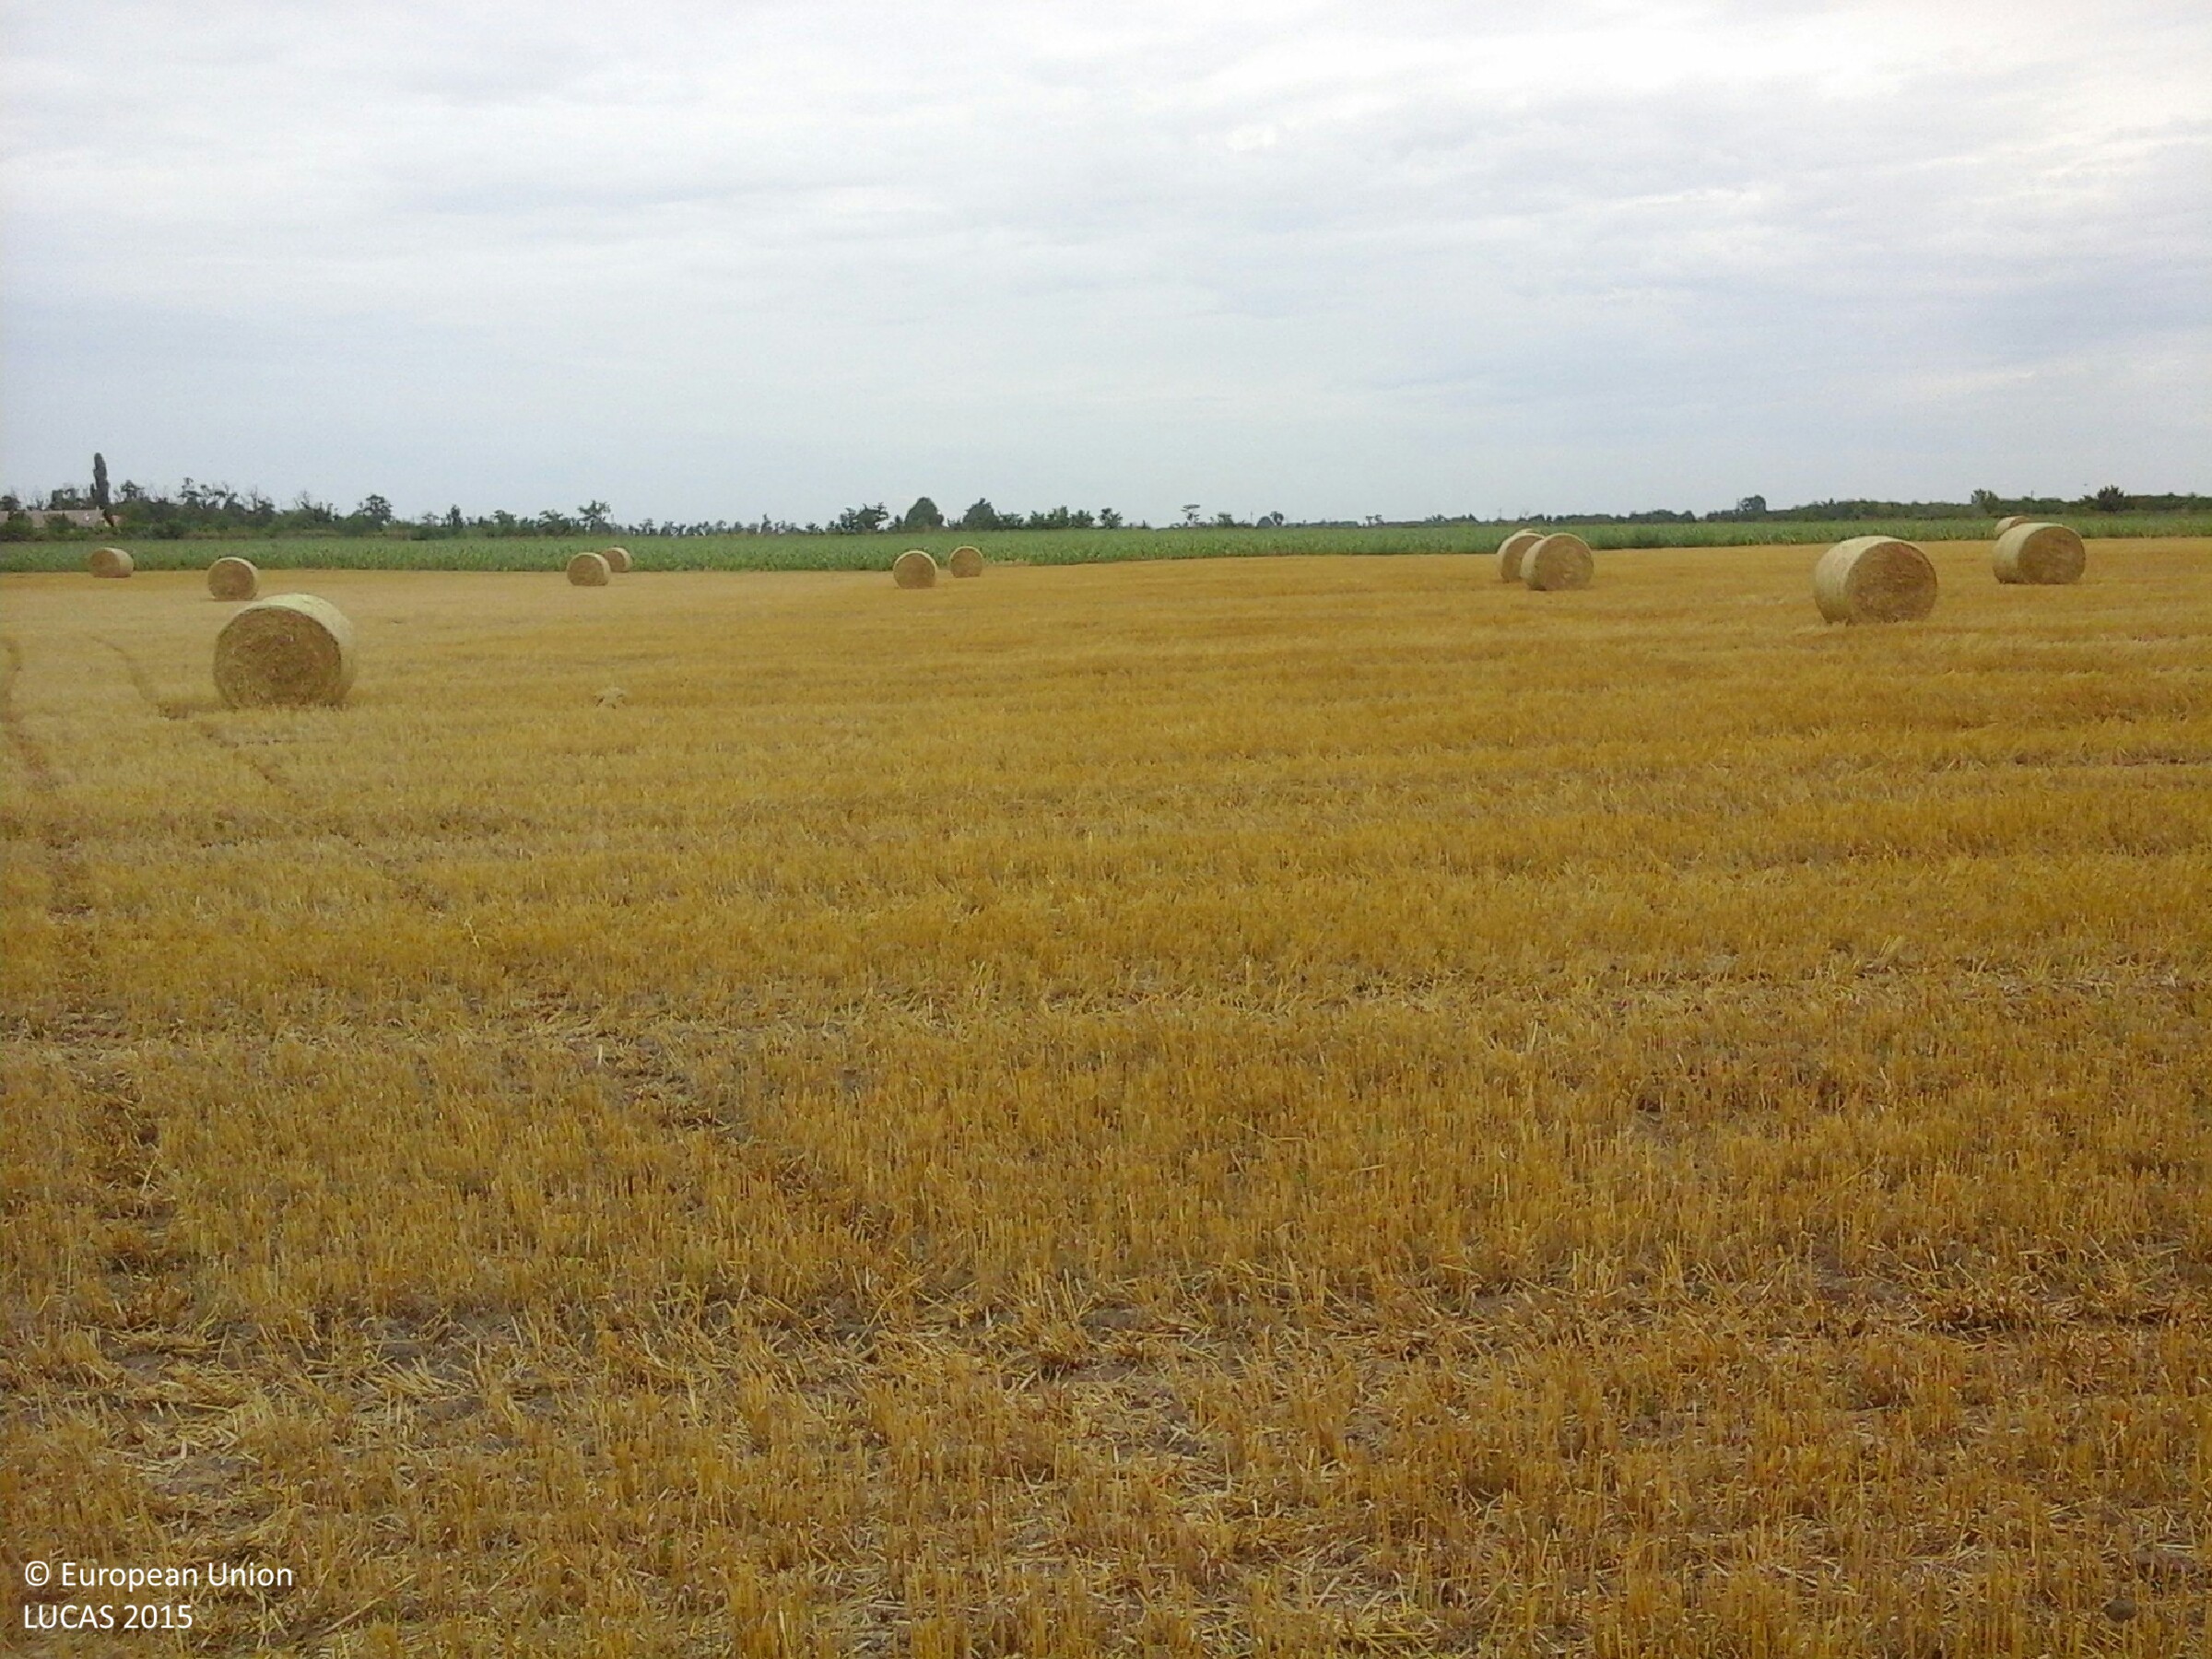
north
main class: Cropland
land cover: Common wheat
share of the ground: 25 - 50 %
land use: Agriculture (excluding fallow land and kitchen gardens)
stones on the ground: < 10 %
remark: Harvested field
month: July
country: HU
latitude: 47.4483
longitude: 20.8701
